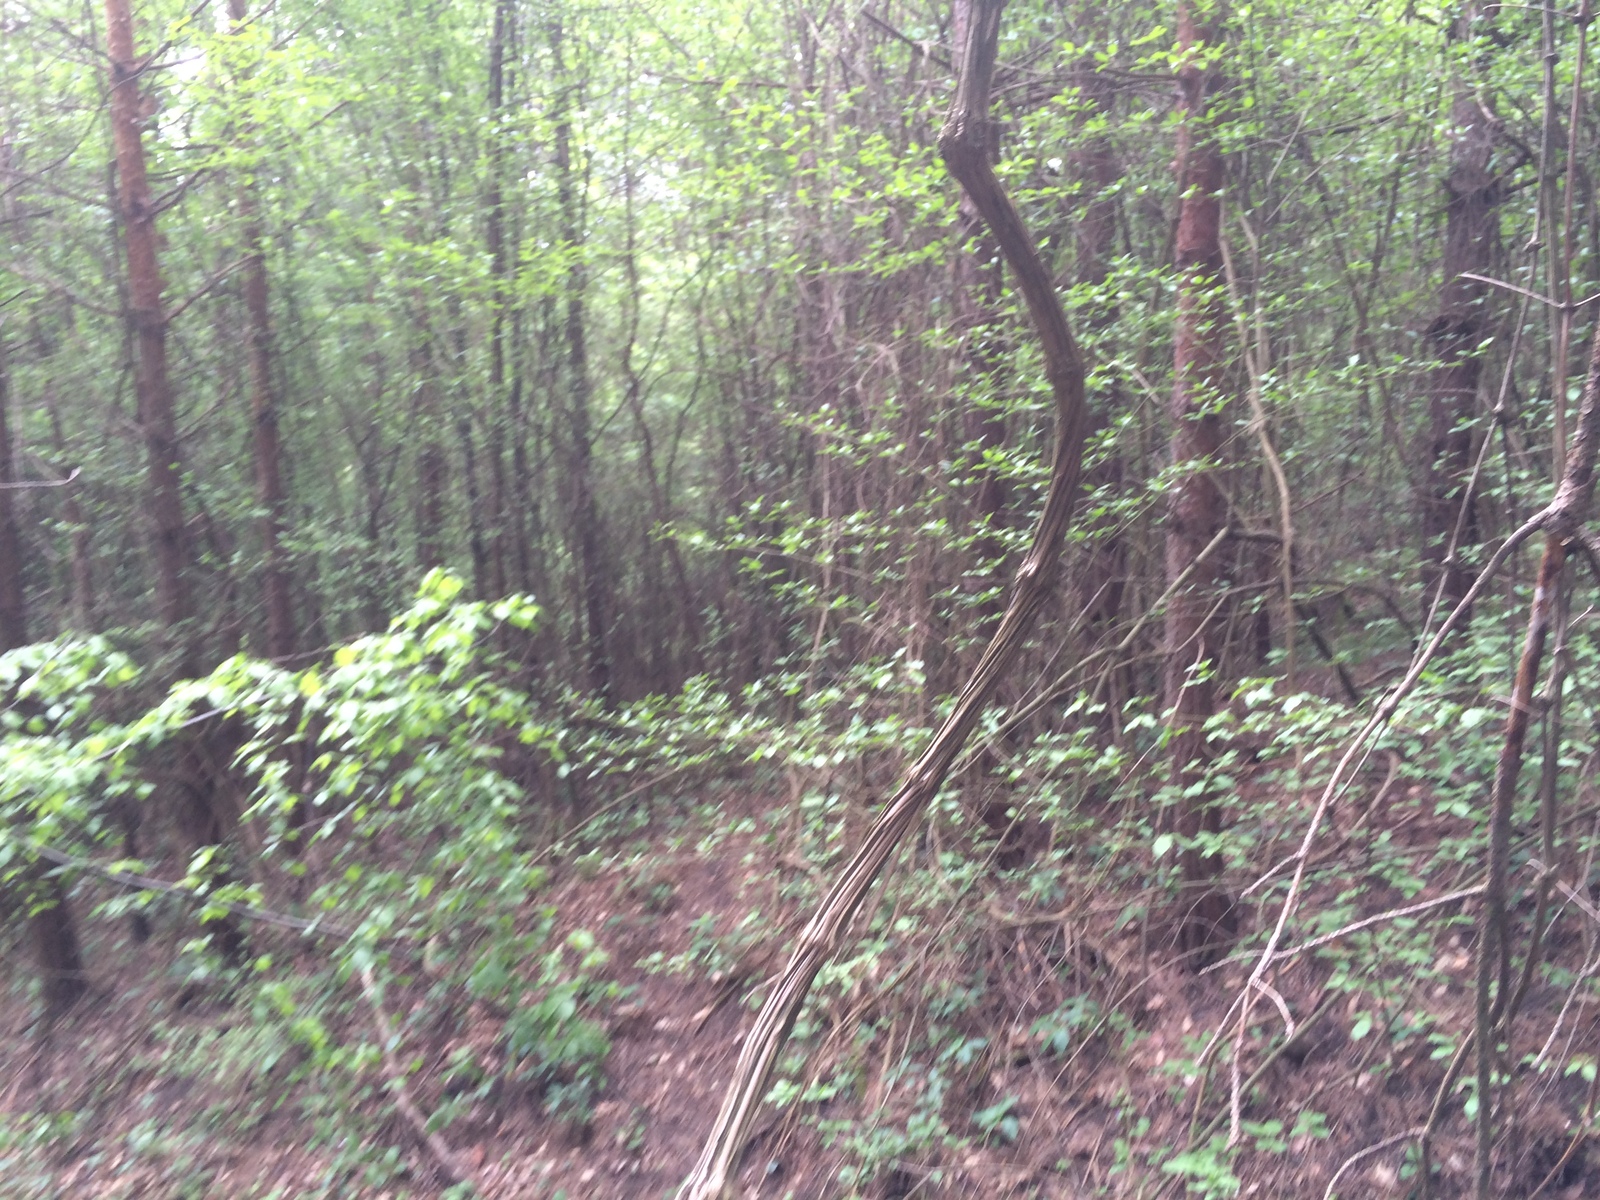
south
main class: Woodland
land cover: Pine dominated mixed woodland
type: mountainous beech forest
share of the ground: > 75 %
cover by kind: broadleaved forest trees 60 %, coniferous forest trees 40 %
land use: Forestry
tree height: > 5 m
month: May
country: AT
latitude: 48.0721
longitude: 16.1105
